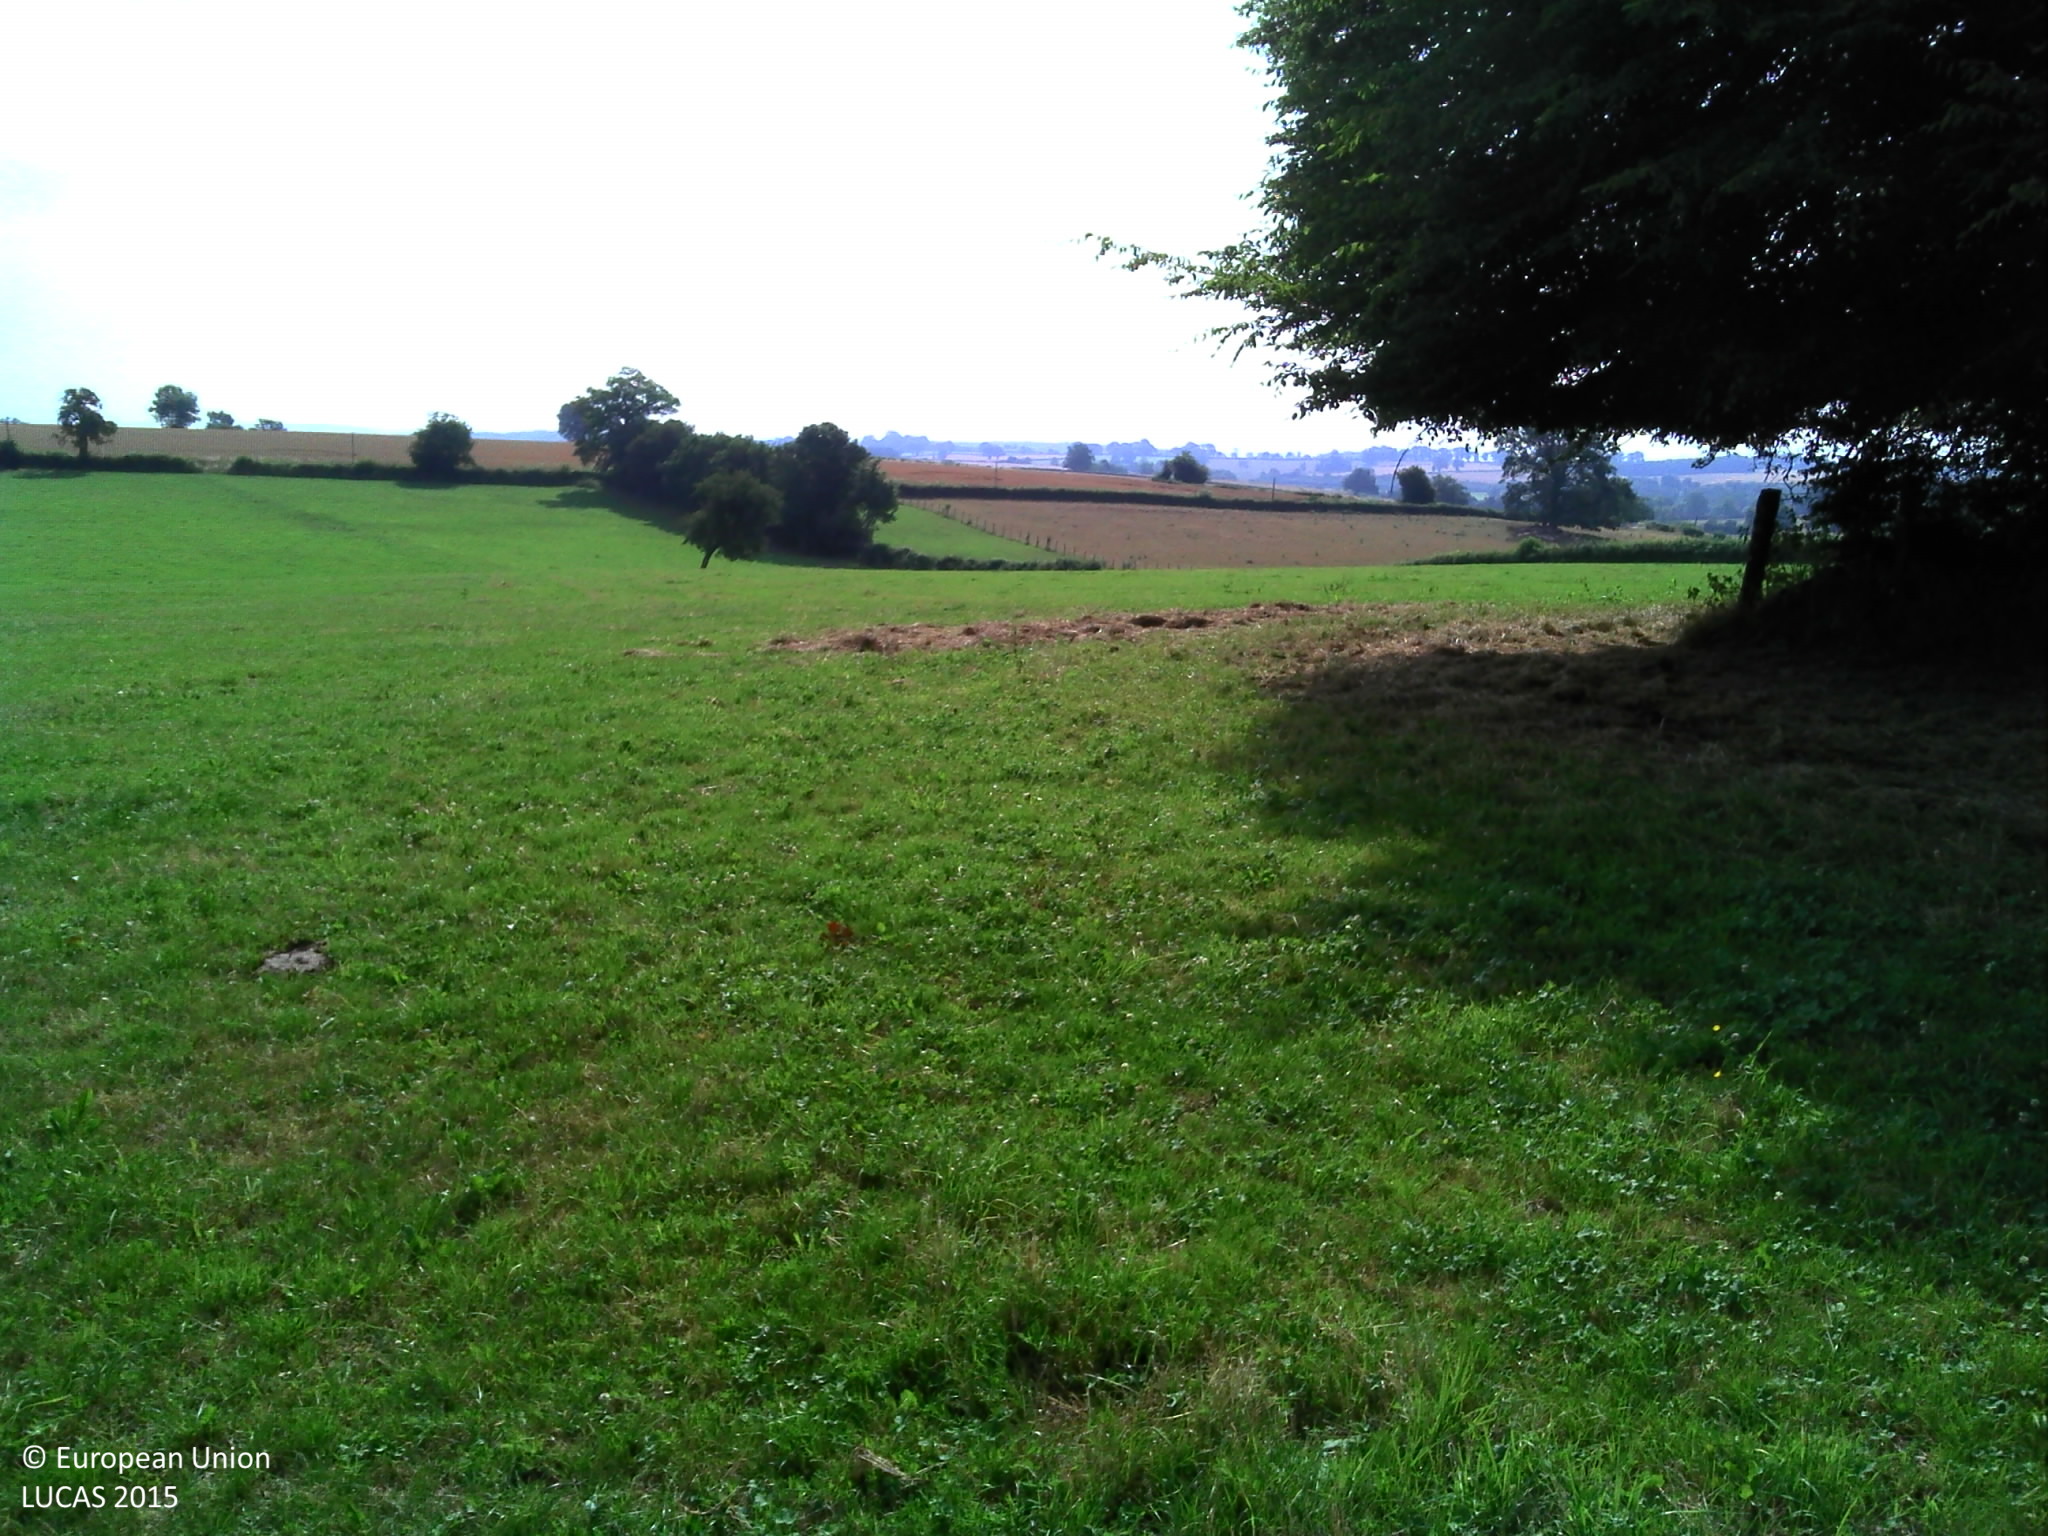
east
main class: Grassland
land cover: Grassland without tree/shrub cover
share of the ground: > 75 %
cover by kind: herbaceous plants 100 %
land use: Agriculture (excluding fallow land and kitchen gardens)
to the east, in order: Grassland without tree/shrub cover; Fences; Managed hedges; Grassland without tree/shrub cover; Fences; Managed hedges; Fences; Grassland without tree/shrub cover
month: July
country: FR
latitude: 47.1350
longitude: 3.6031
